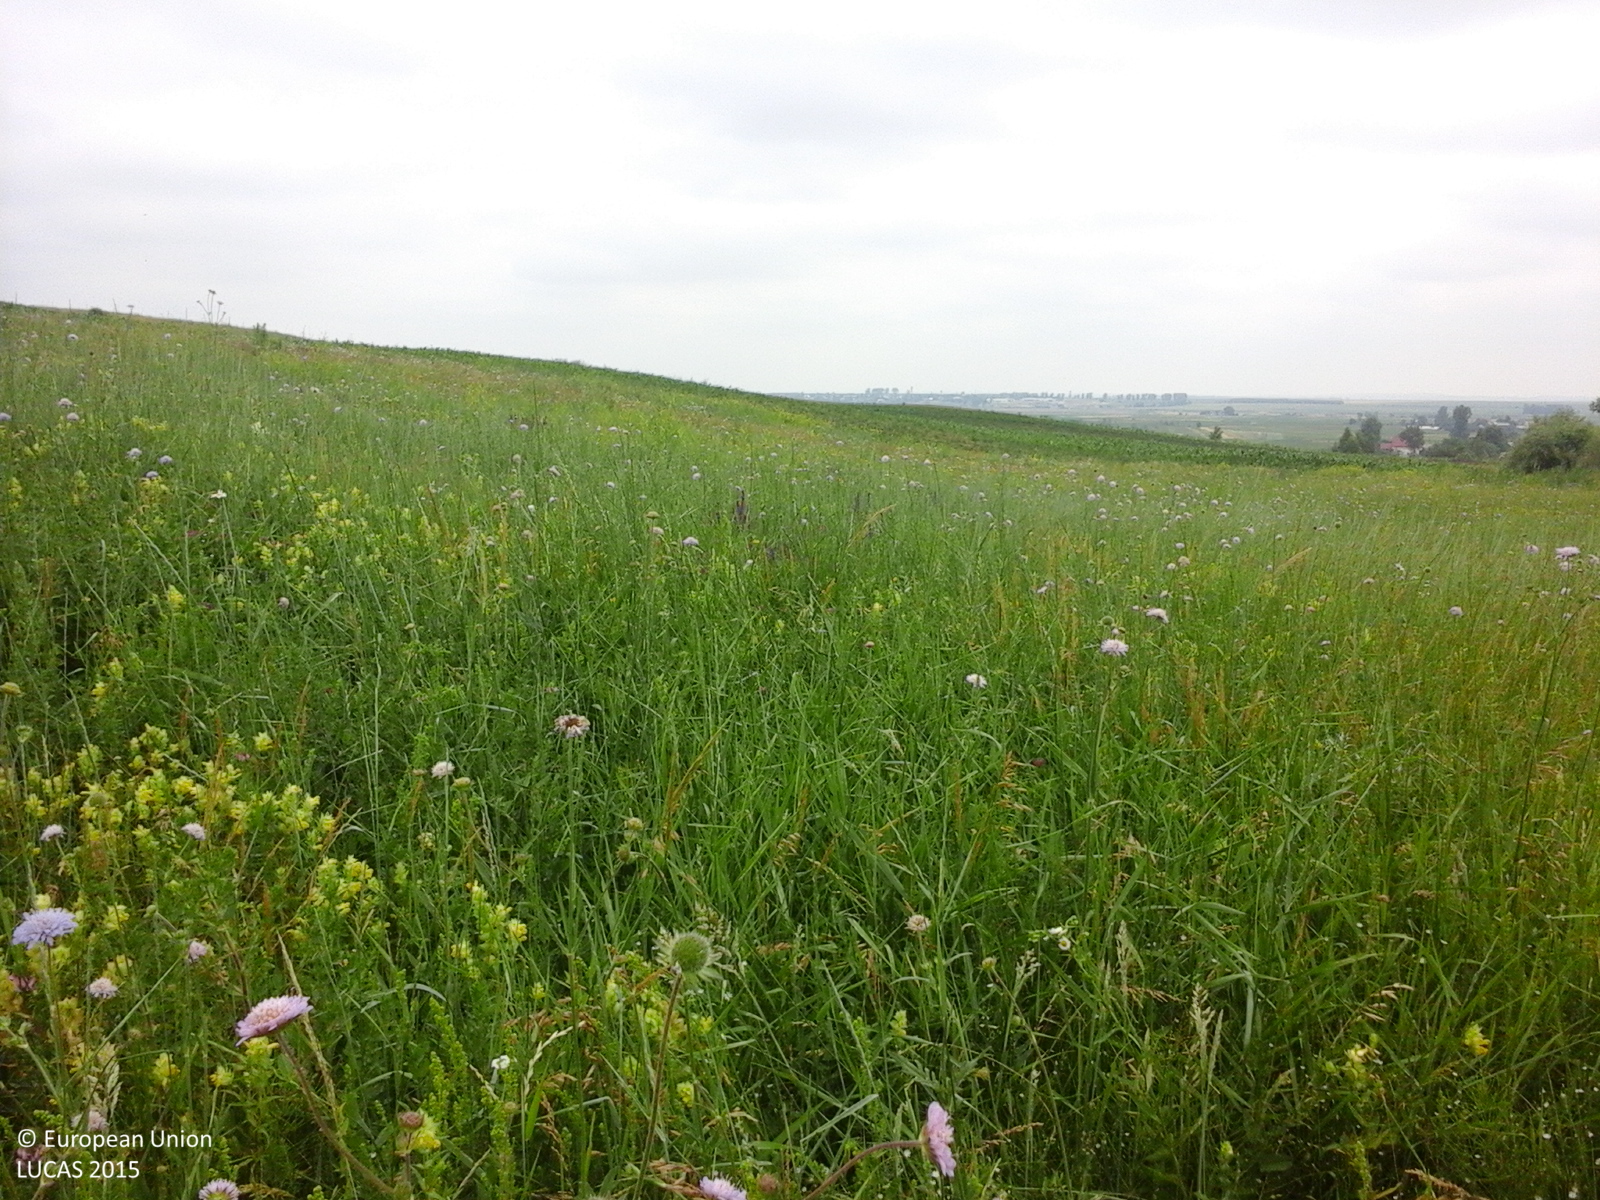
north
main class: Grassland
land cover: Grassland without tree/shrub cover
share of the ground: > 75 %
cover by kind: herbaceous plants 100 %
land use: Agriculture (excluding fallow land and kitchen gardens)
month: June
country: RO
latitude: 47.5641
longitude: 26.4496
